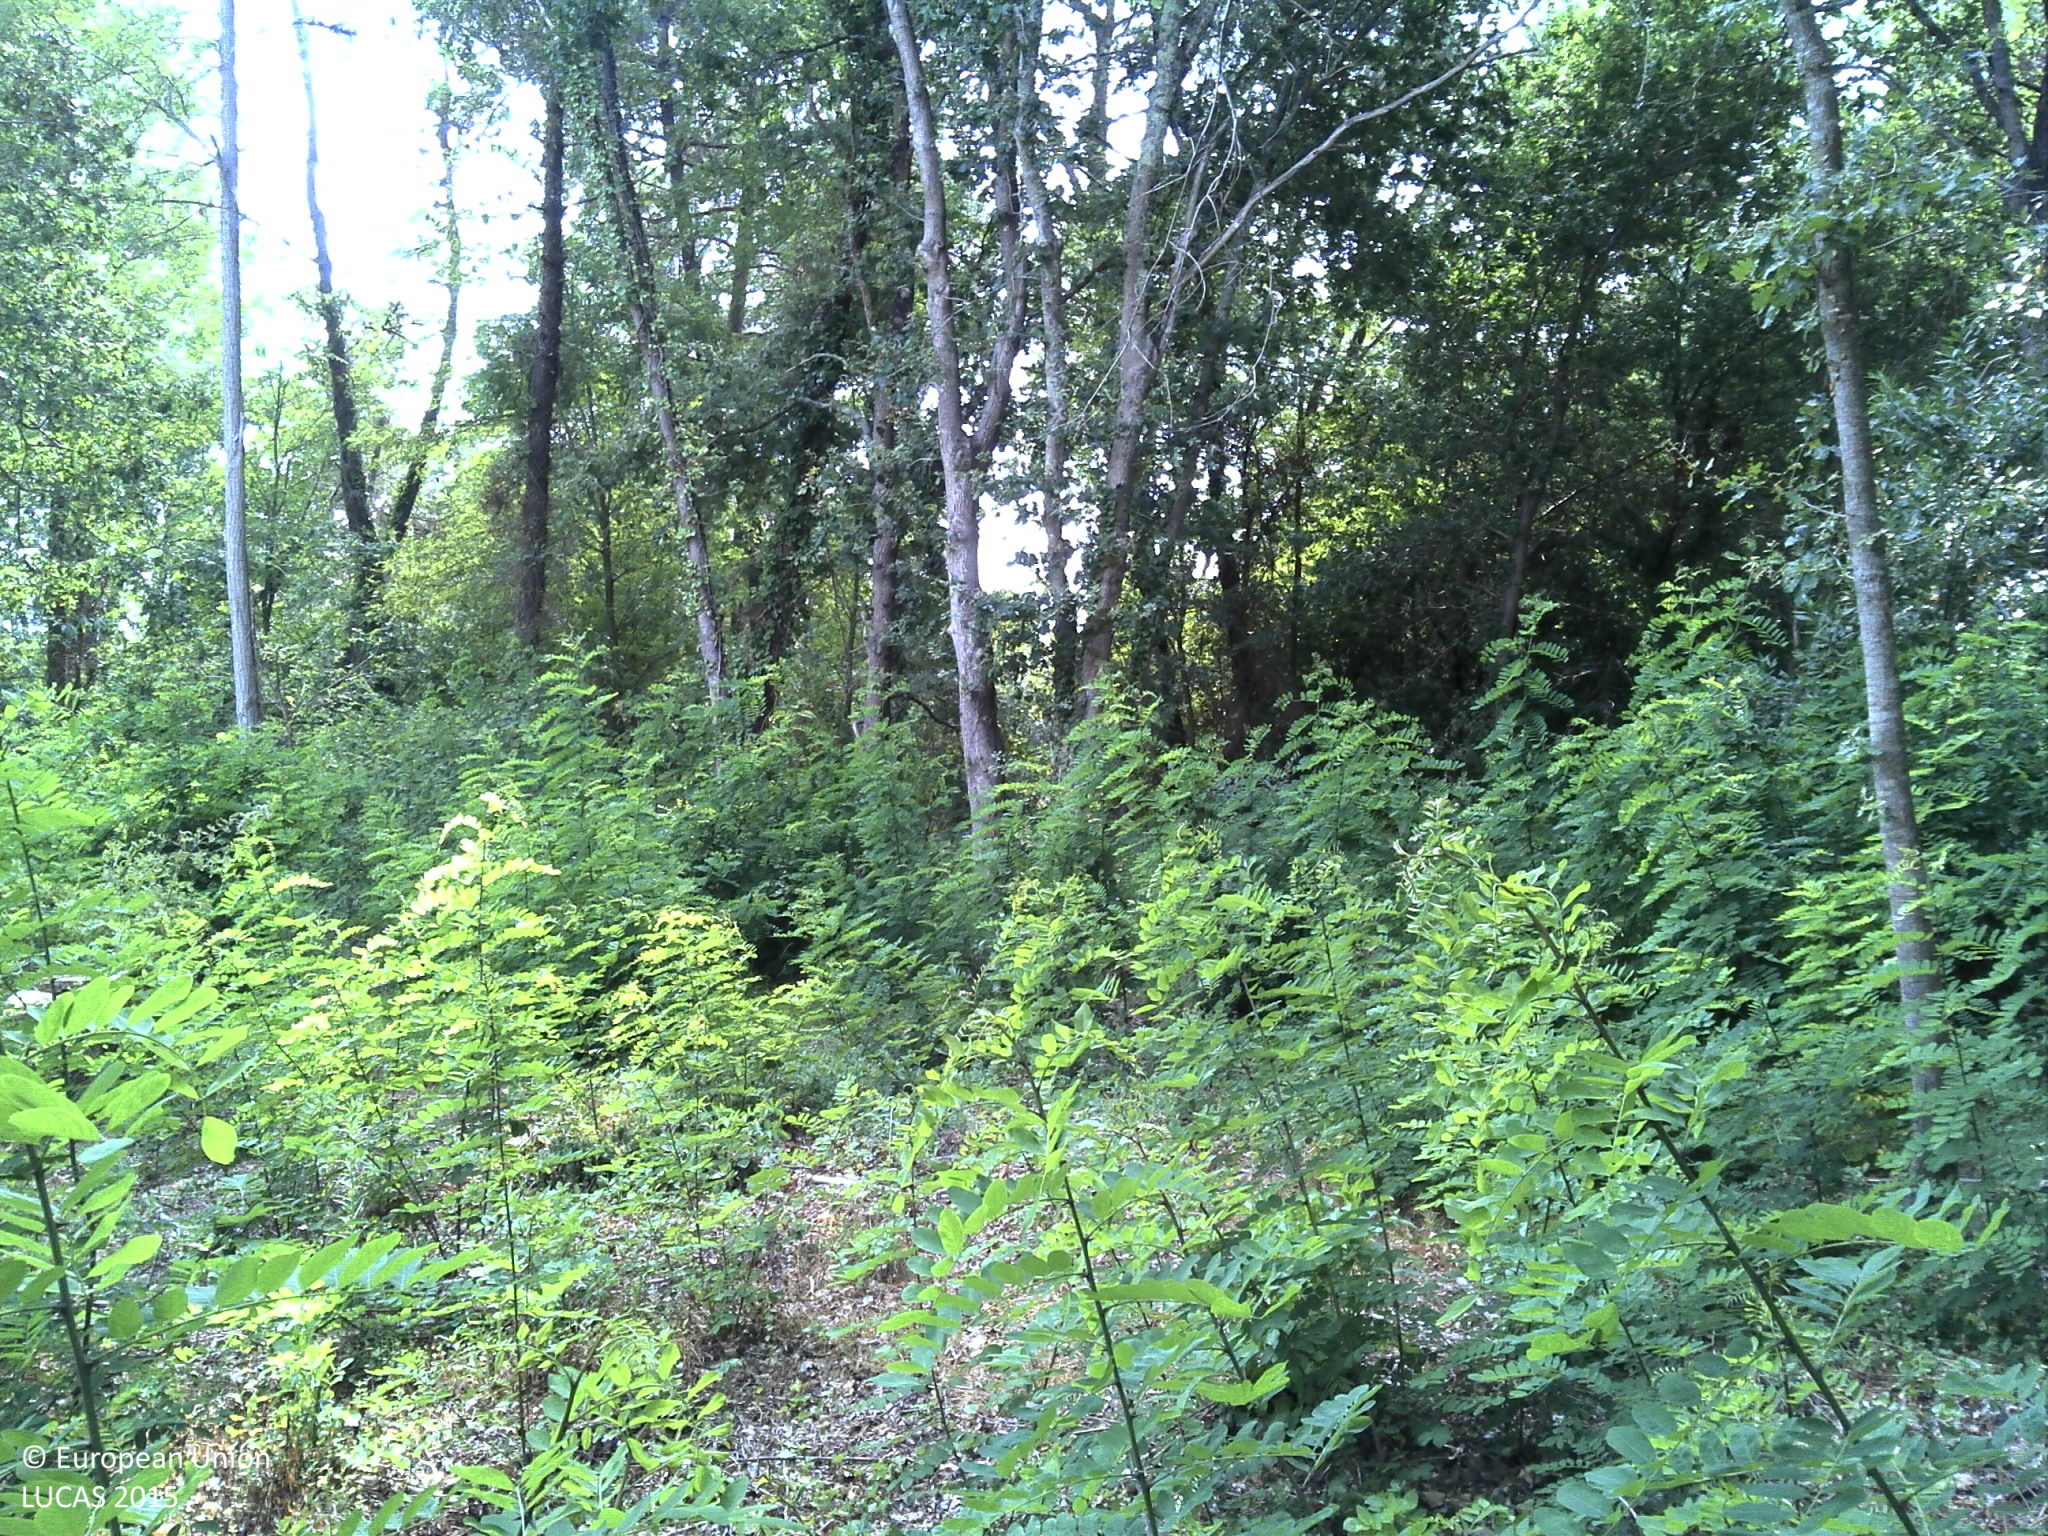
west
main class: Woodland
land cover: Broadleaved woodland
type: thermophilous deciduous forest
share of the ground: > 75 %
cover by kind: broadleaved forest trees 40 %, herbaceous plants 40 %, shrubs 20 %
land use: Semi-natural and natural areas not in use
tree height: > 5 m
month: August
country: FR
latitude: 45.0551
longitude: -0.4693
